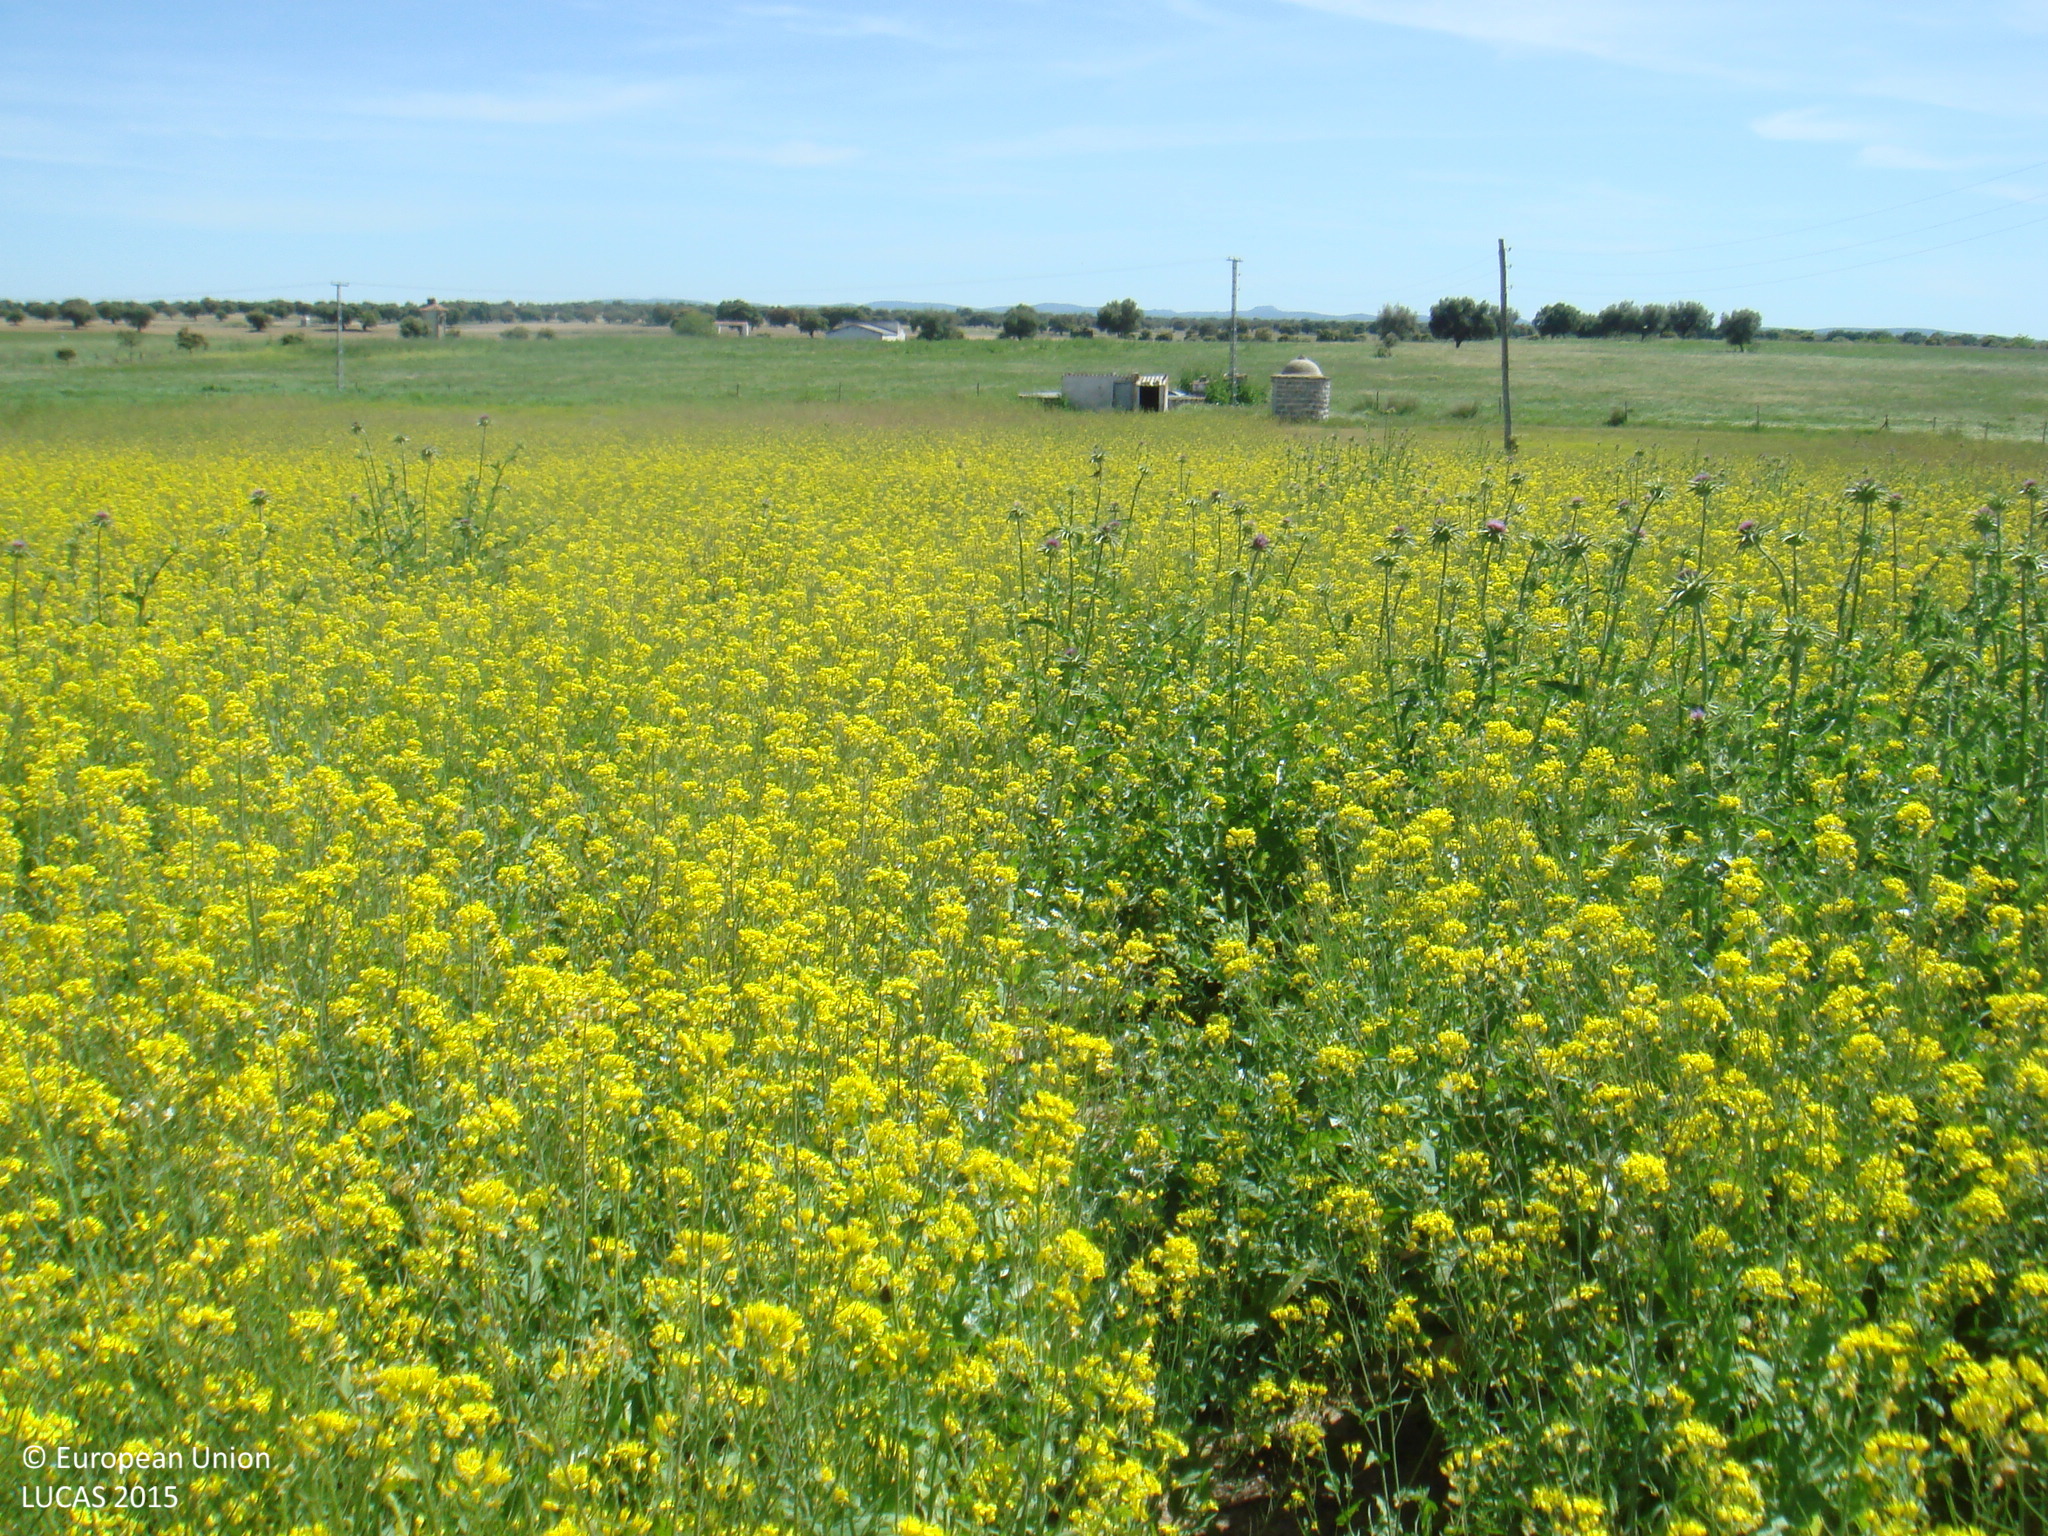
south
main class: Grassland
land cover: Spontaneously vegetated surfaces
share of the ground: > 75 %
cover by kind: herbaceous plants 95 %, shrubs 5 %
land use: Fallow land
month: April
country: ES
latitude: 38.5017
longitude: -5.1079
